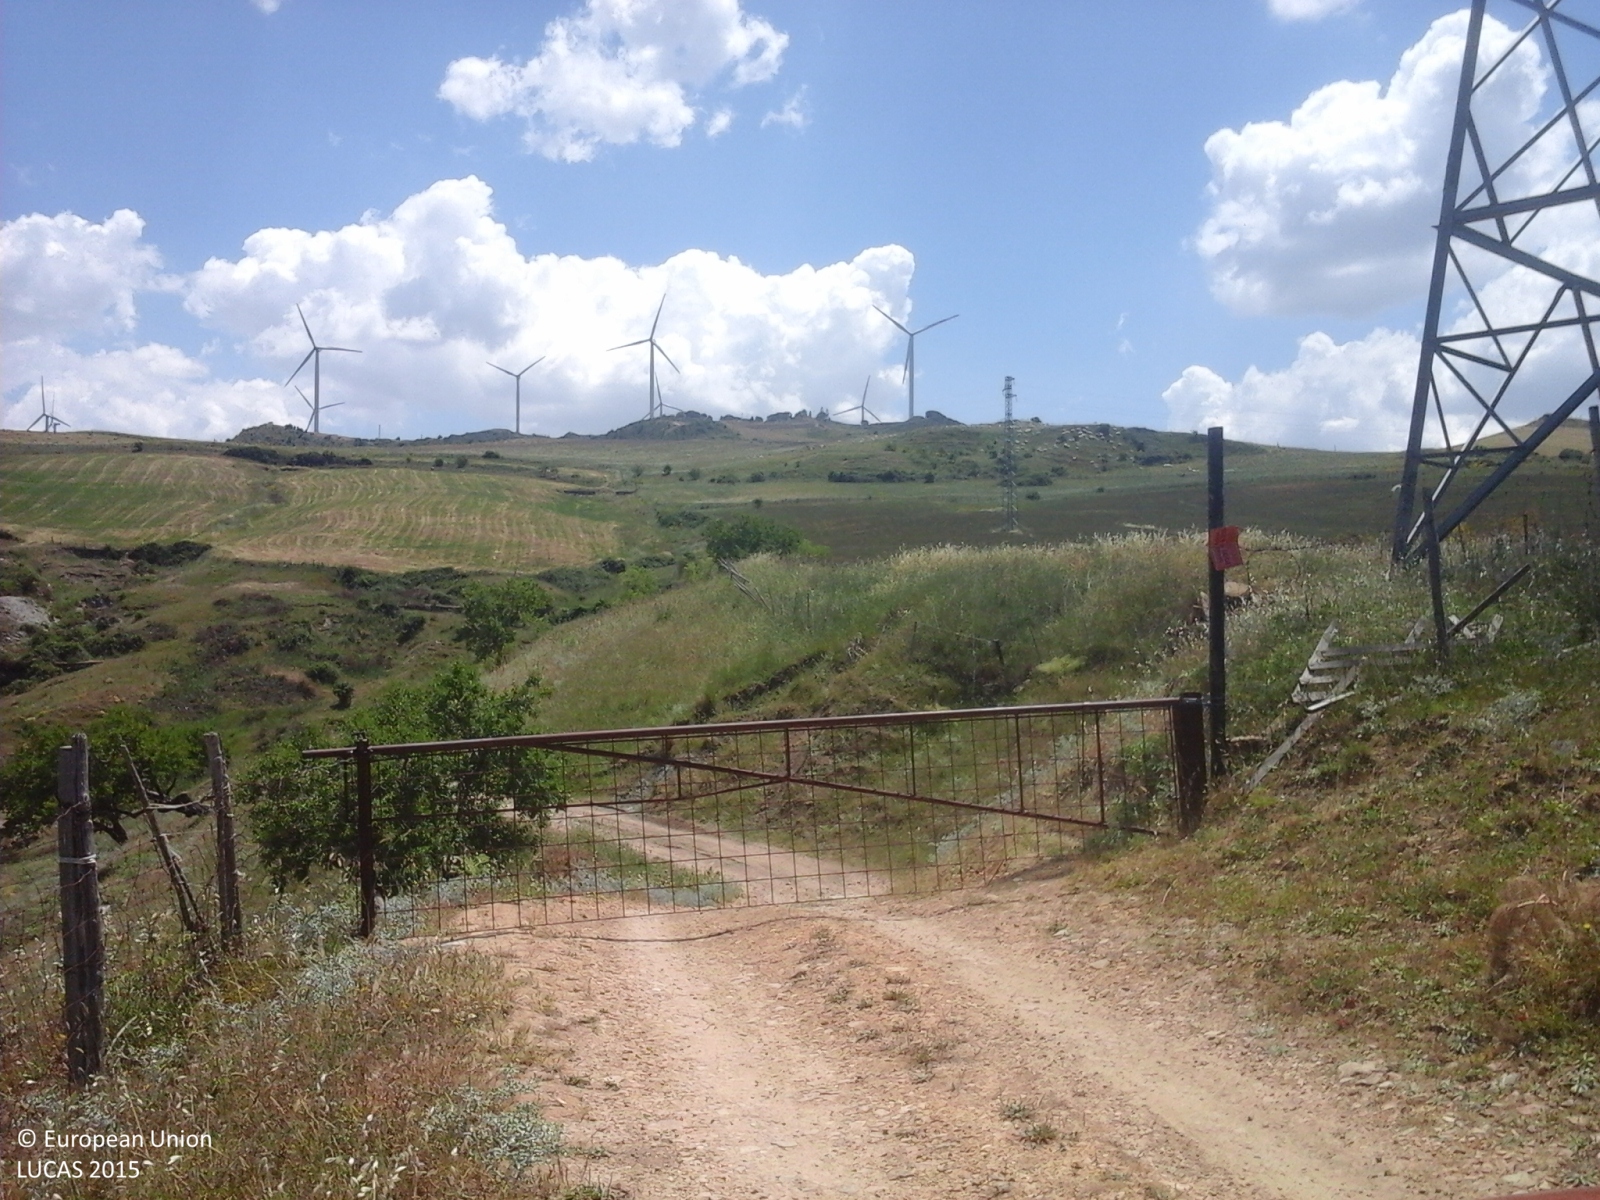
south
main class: Grassland
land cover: Grassland with sparse tree/shrub cover
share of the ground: > 75 %
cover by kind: herbaceous plants 90 %, broadleaved forest trees 5 %, shrubs 5 %
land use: Agriculture (excluding fallow land and kitchen gardens)
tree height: > 5 m
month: June
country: IT
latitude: 37.7459
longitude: 14.5866
